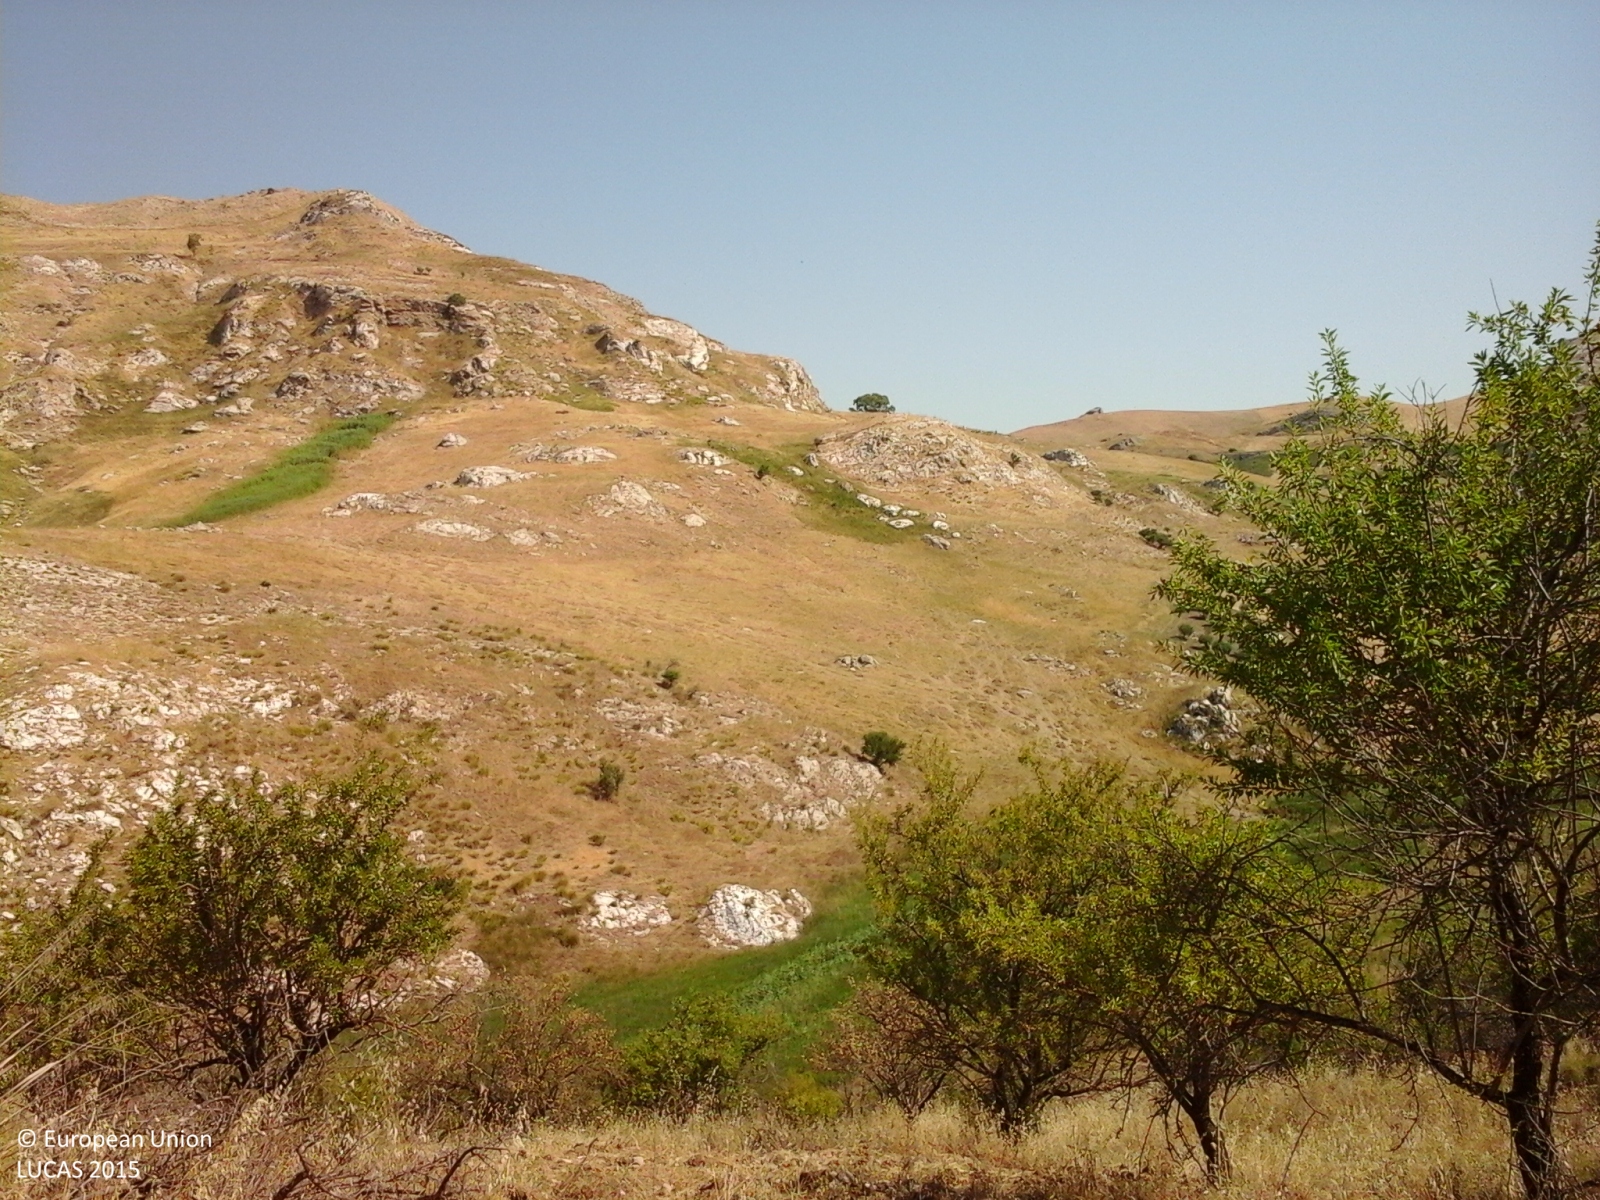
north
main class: Cropland
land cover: Nuts trees
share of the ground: 25 - 50 %
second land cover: Spontaneously vegetated surfaces
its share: > 75 %
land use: Agriculture (excluding fallow land and kitchen gardens)
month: July
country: IT
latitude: 37.4473
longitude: 13.4886
